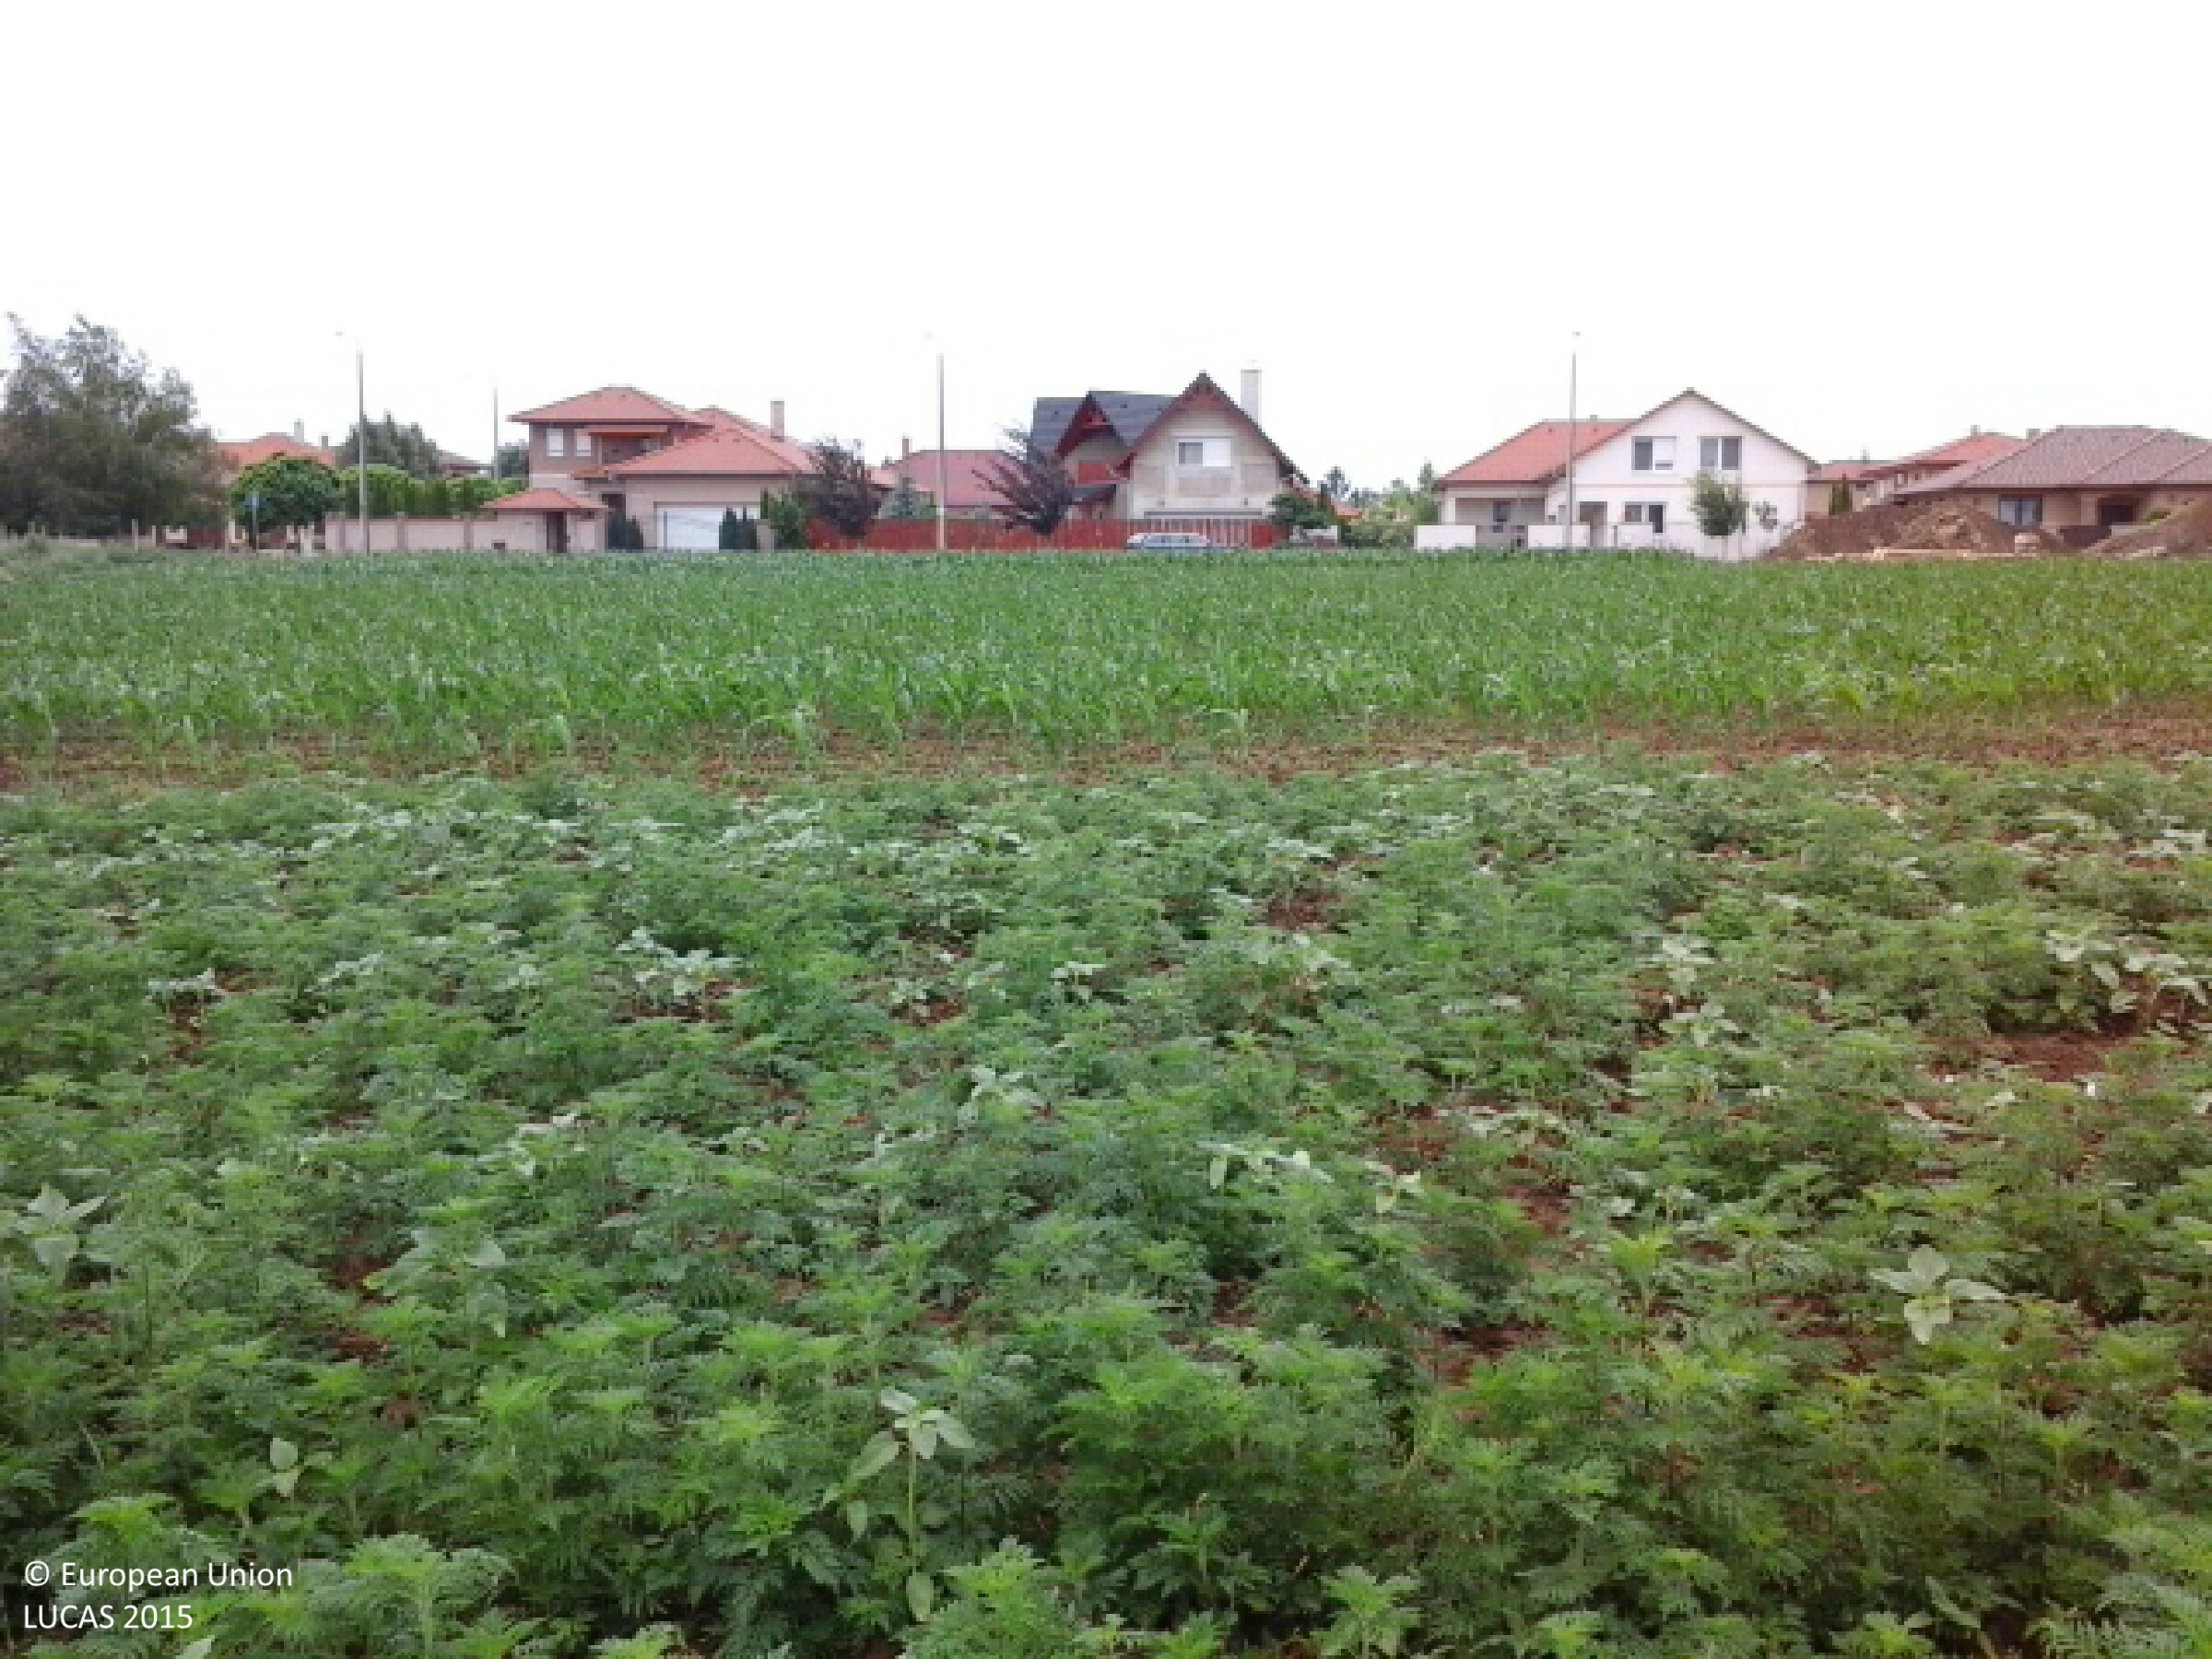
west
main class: Cropland
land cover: Sunflower
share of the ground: 10 - 25 %
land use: Agriculture (excluding fallow land and kitchen gardens)
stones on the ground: < 10 %
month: June
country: HU
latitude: 47.9547
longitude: 21.7655
